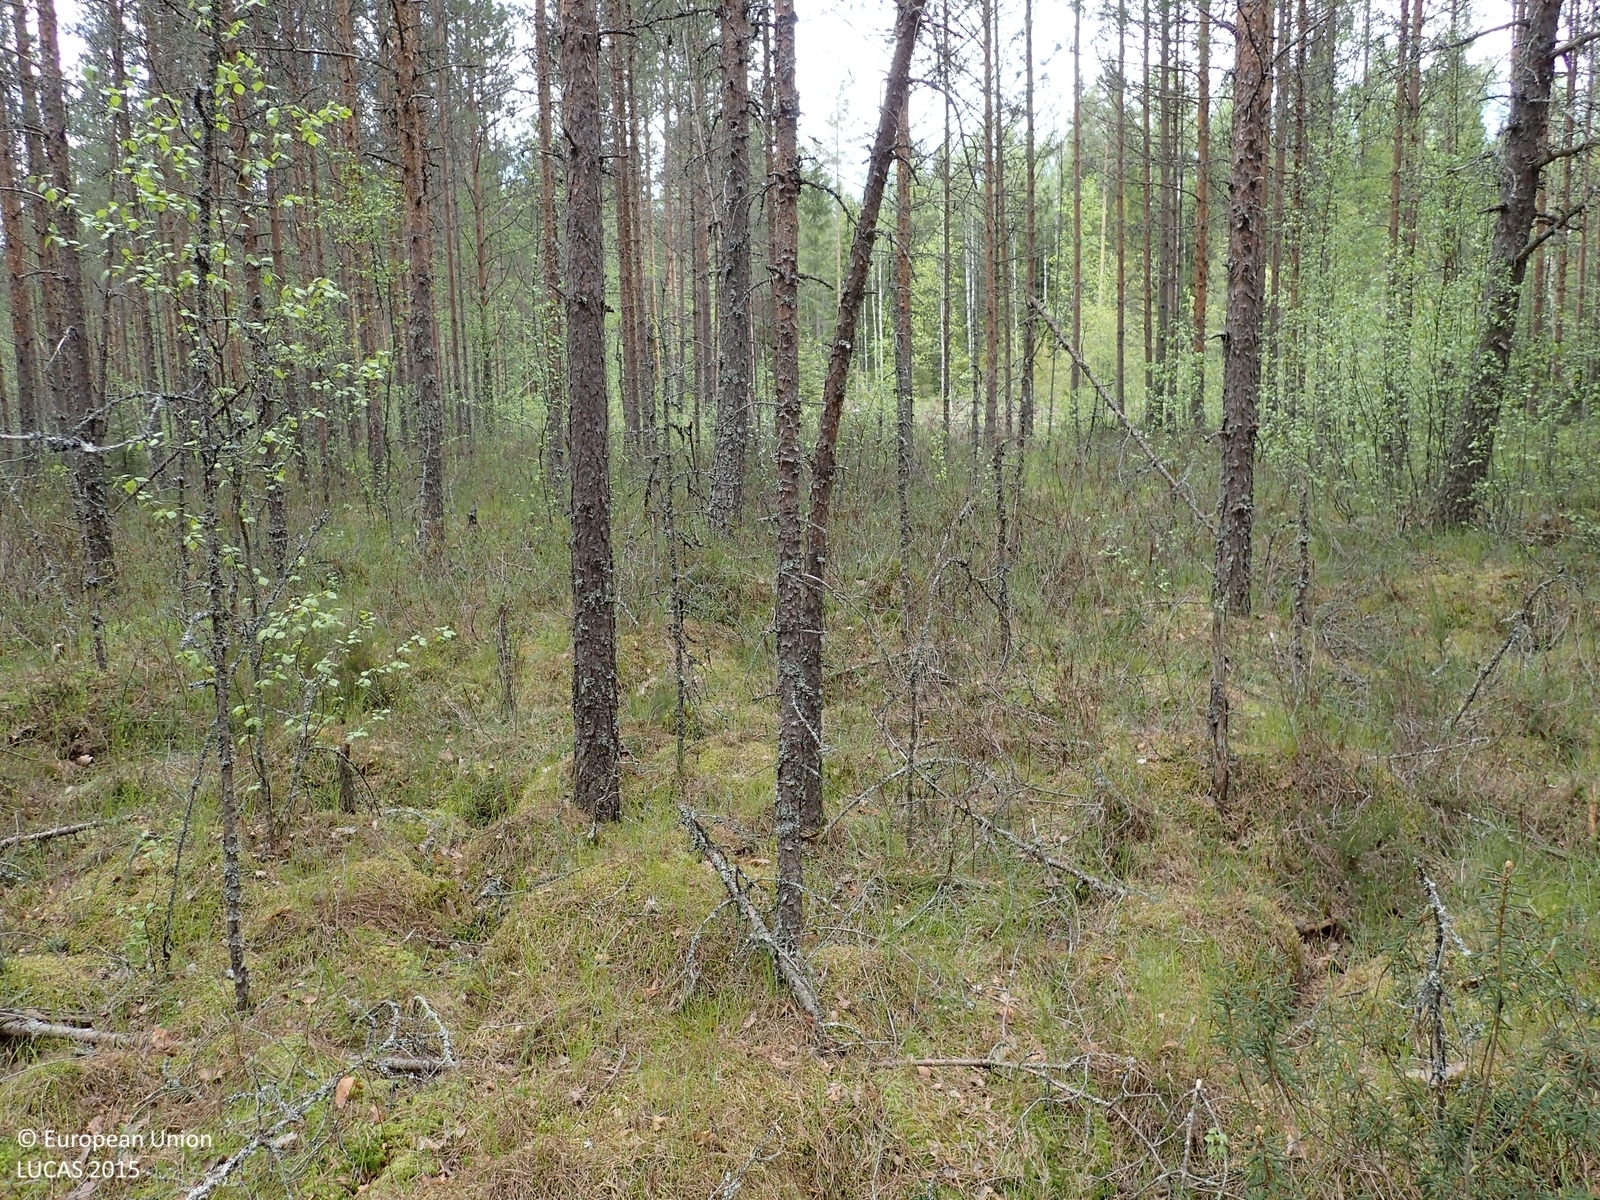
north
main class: Woodland
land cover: Pine dominated coniferous woodland
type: boreal forest
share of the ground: > 75 %
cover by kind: coniferous forest trees 80 %, shrubs 10 %, broadleaved forest trees 5 %, lichens and mosses 5 %
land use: Forestry
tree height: > 5 m
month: June
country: FI
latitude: 62.2375
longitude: 21.8067
